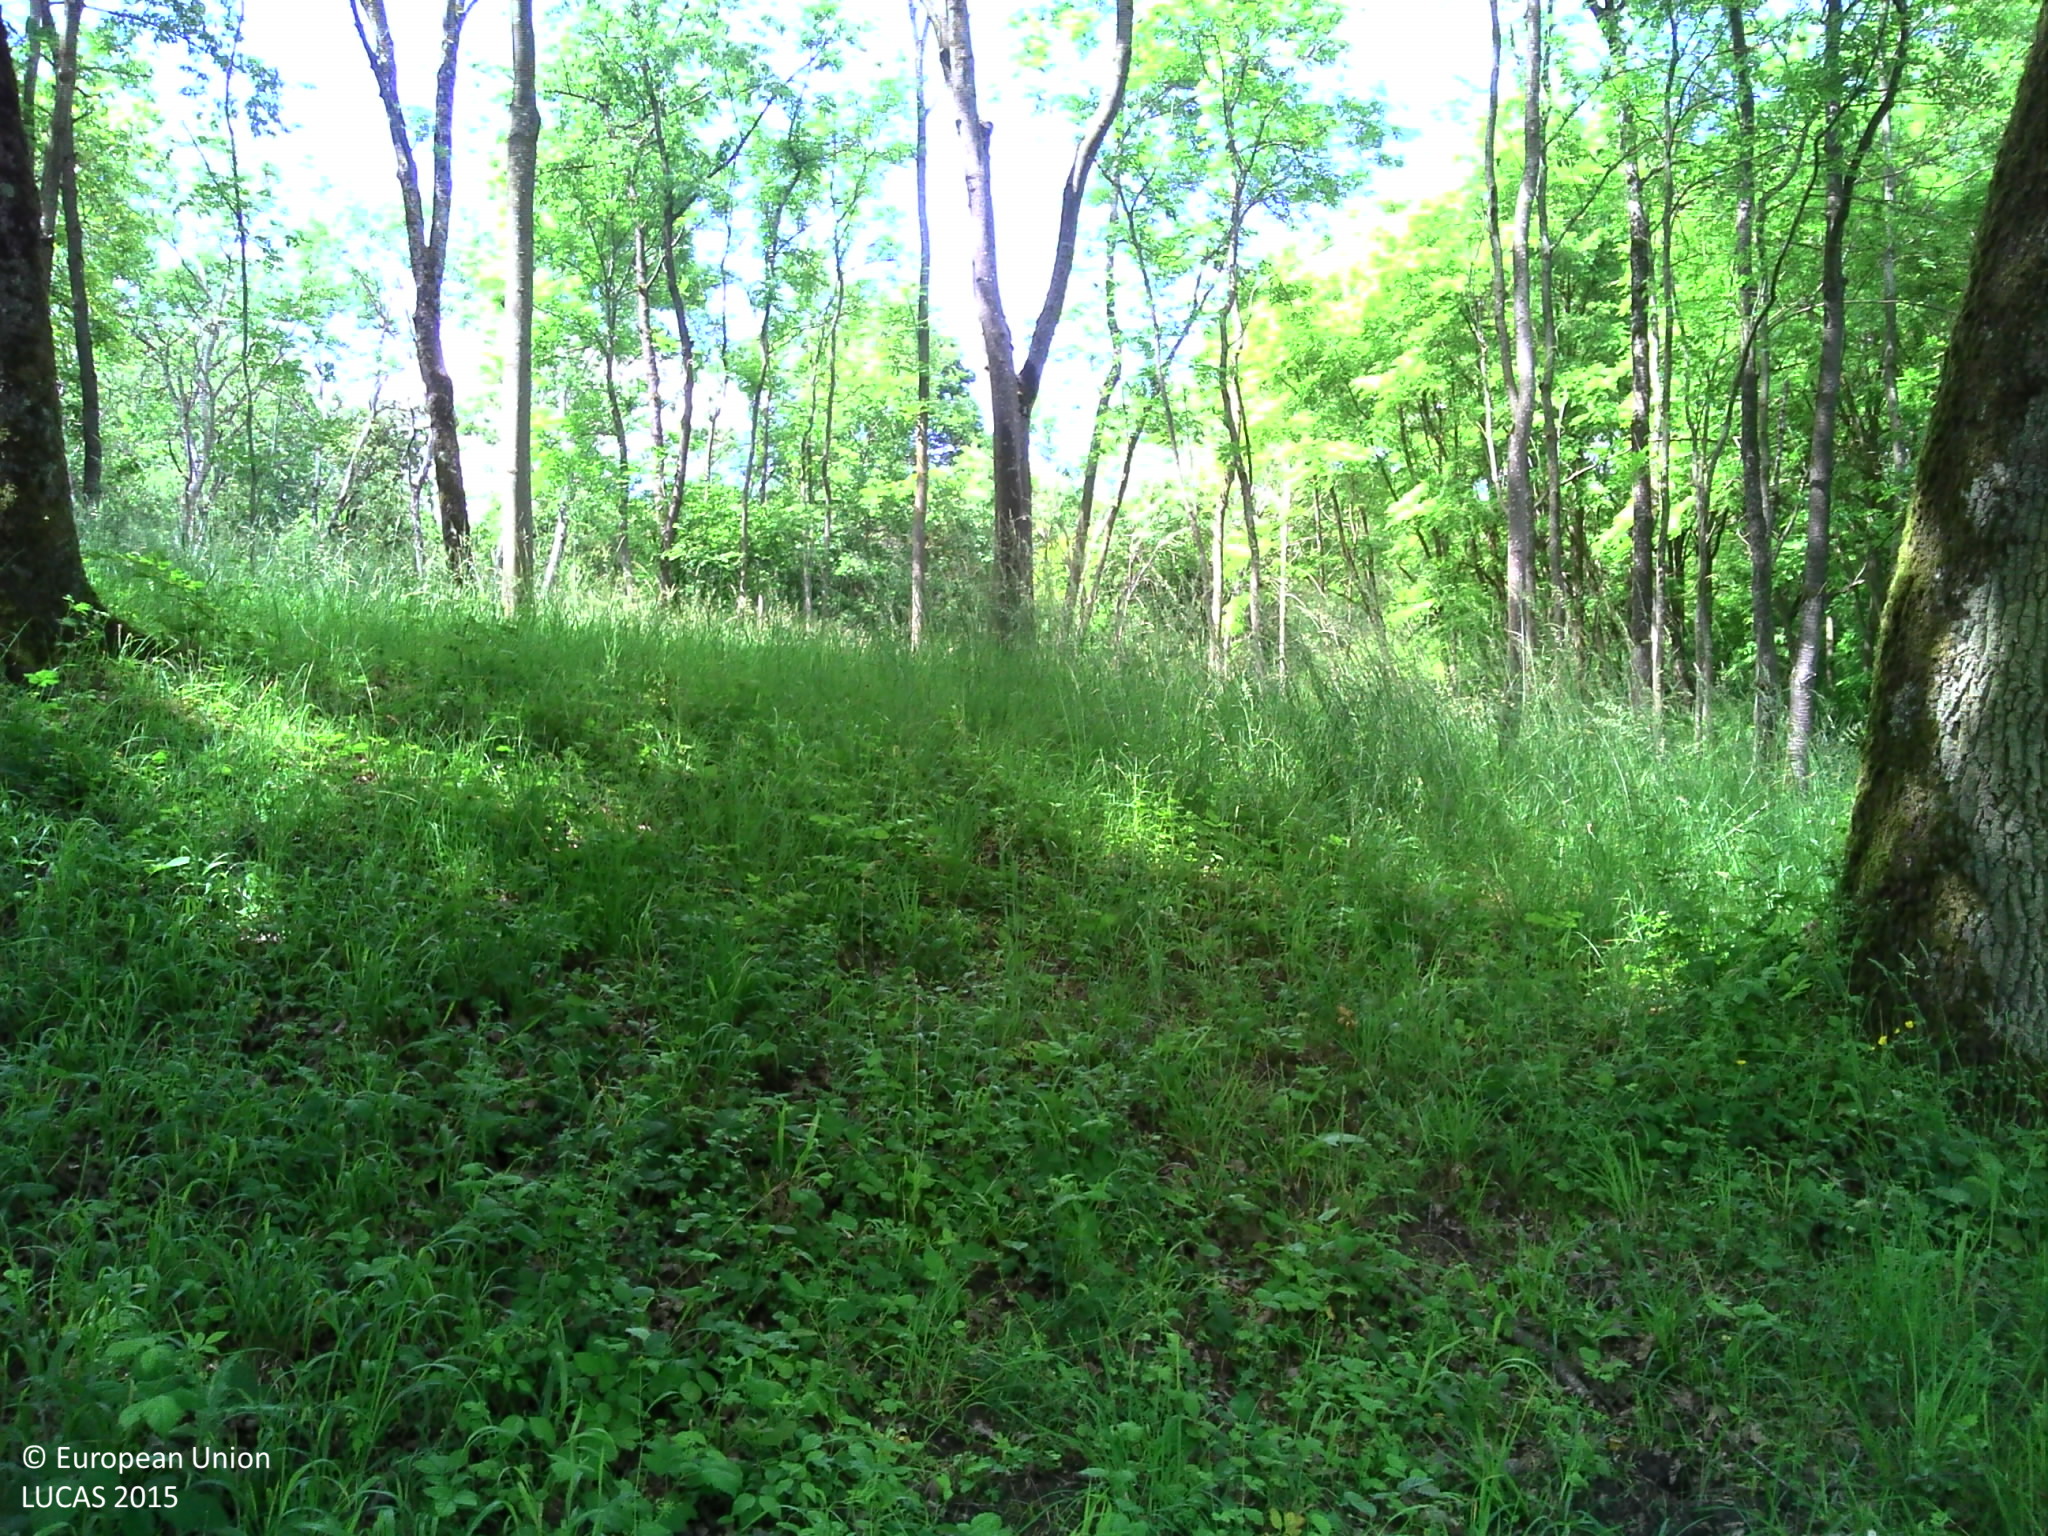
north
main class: Woodland
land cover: Broadleaved woodland
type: mesophytic deciduous forest
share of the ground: > 75 %
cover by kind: broadleaved forest trees 50 %, herbaceous plants 50 %
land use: Agriculture (excluding fallow land and kitchen gardens)
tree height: > 5 m
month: June
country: FR
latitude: 48.6476
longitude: 6.2947
